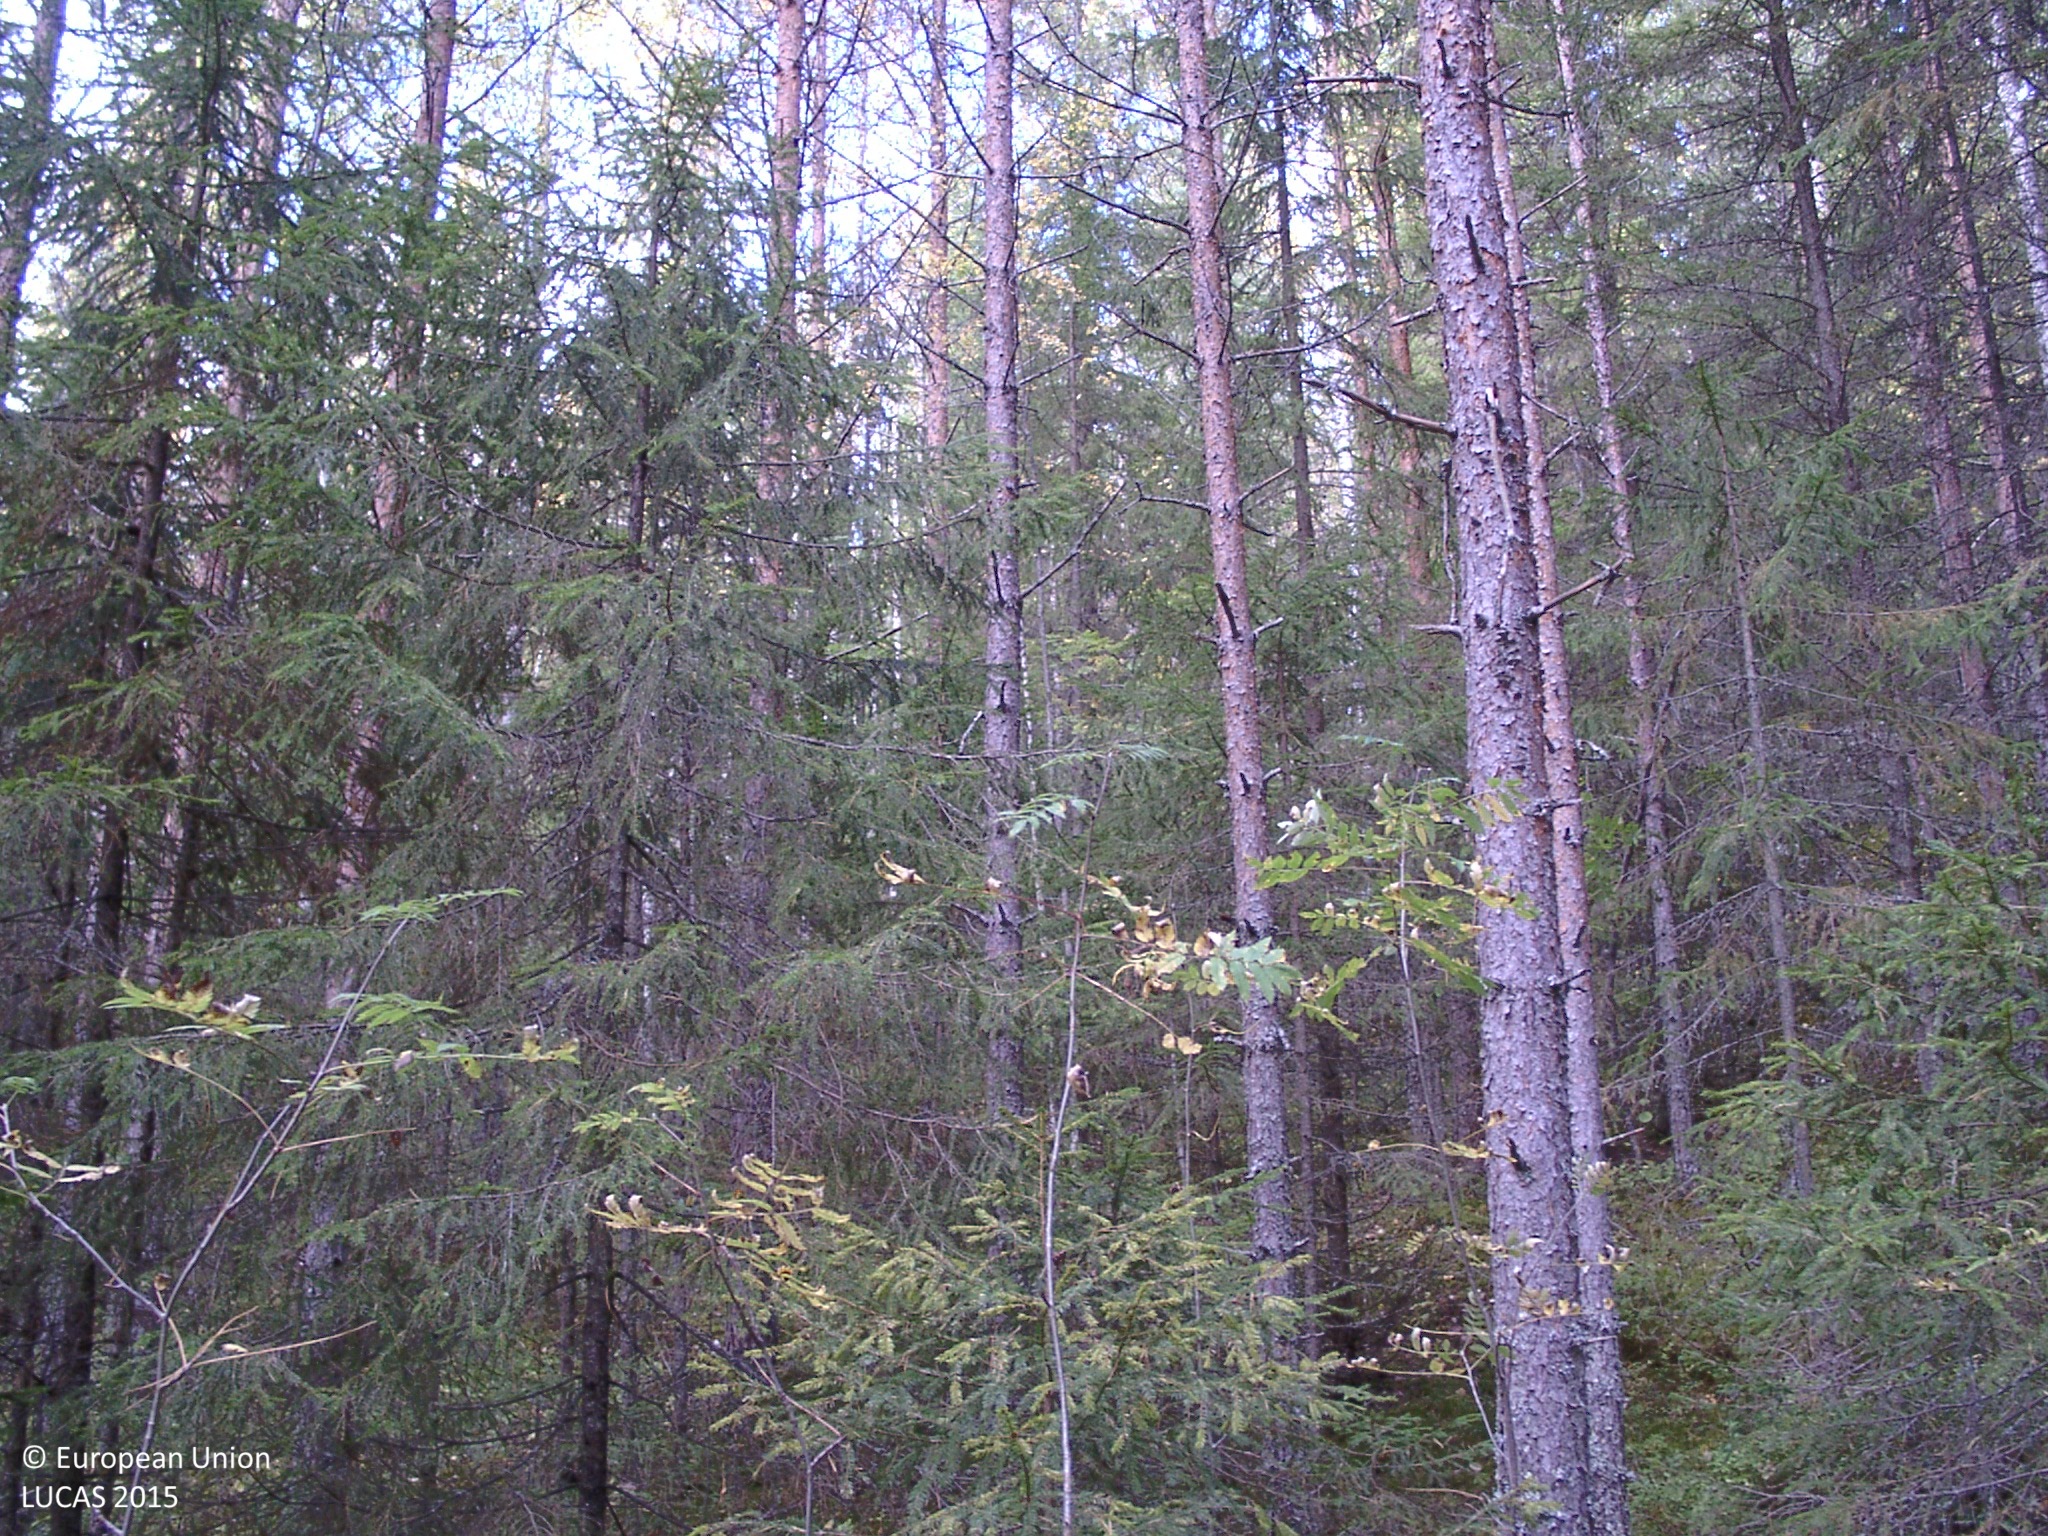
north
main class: Woodland
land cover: Other coniferous woodland
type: boreal forest
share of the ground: > 75 %
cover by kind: coniferous forest trees 80 %, shrubs 10 %, herbaceous plants 5 %, lichens and mosses 5 %
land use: Forestry
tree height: > 5 m
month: September
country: FI
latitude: 62.5611
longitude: 25.2987
